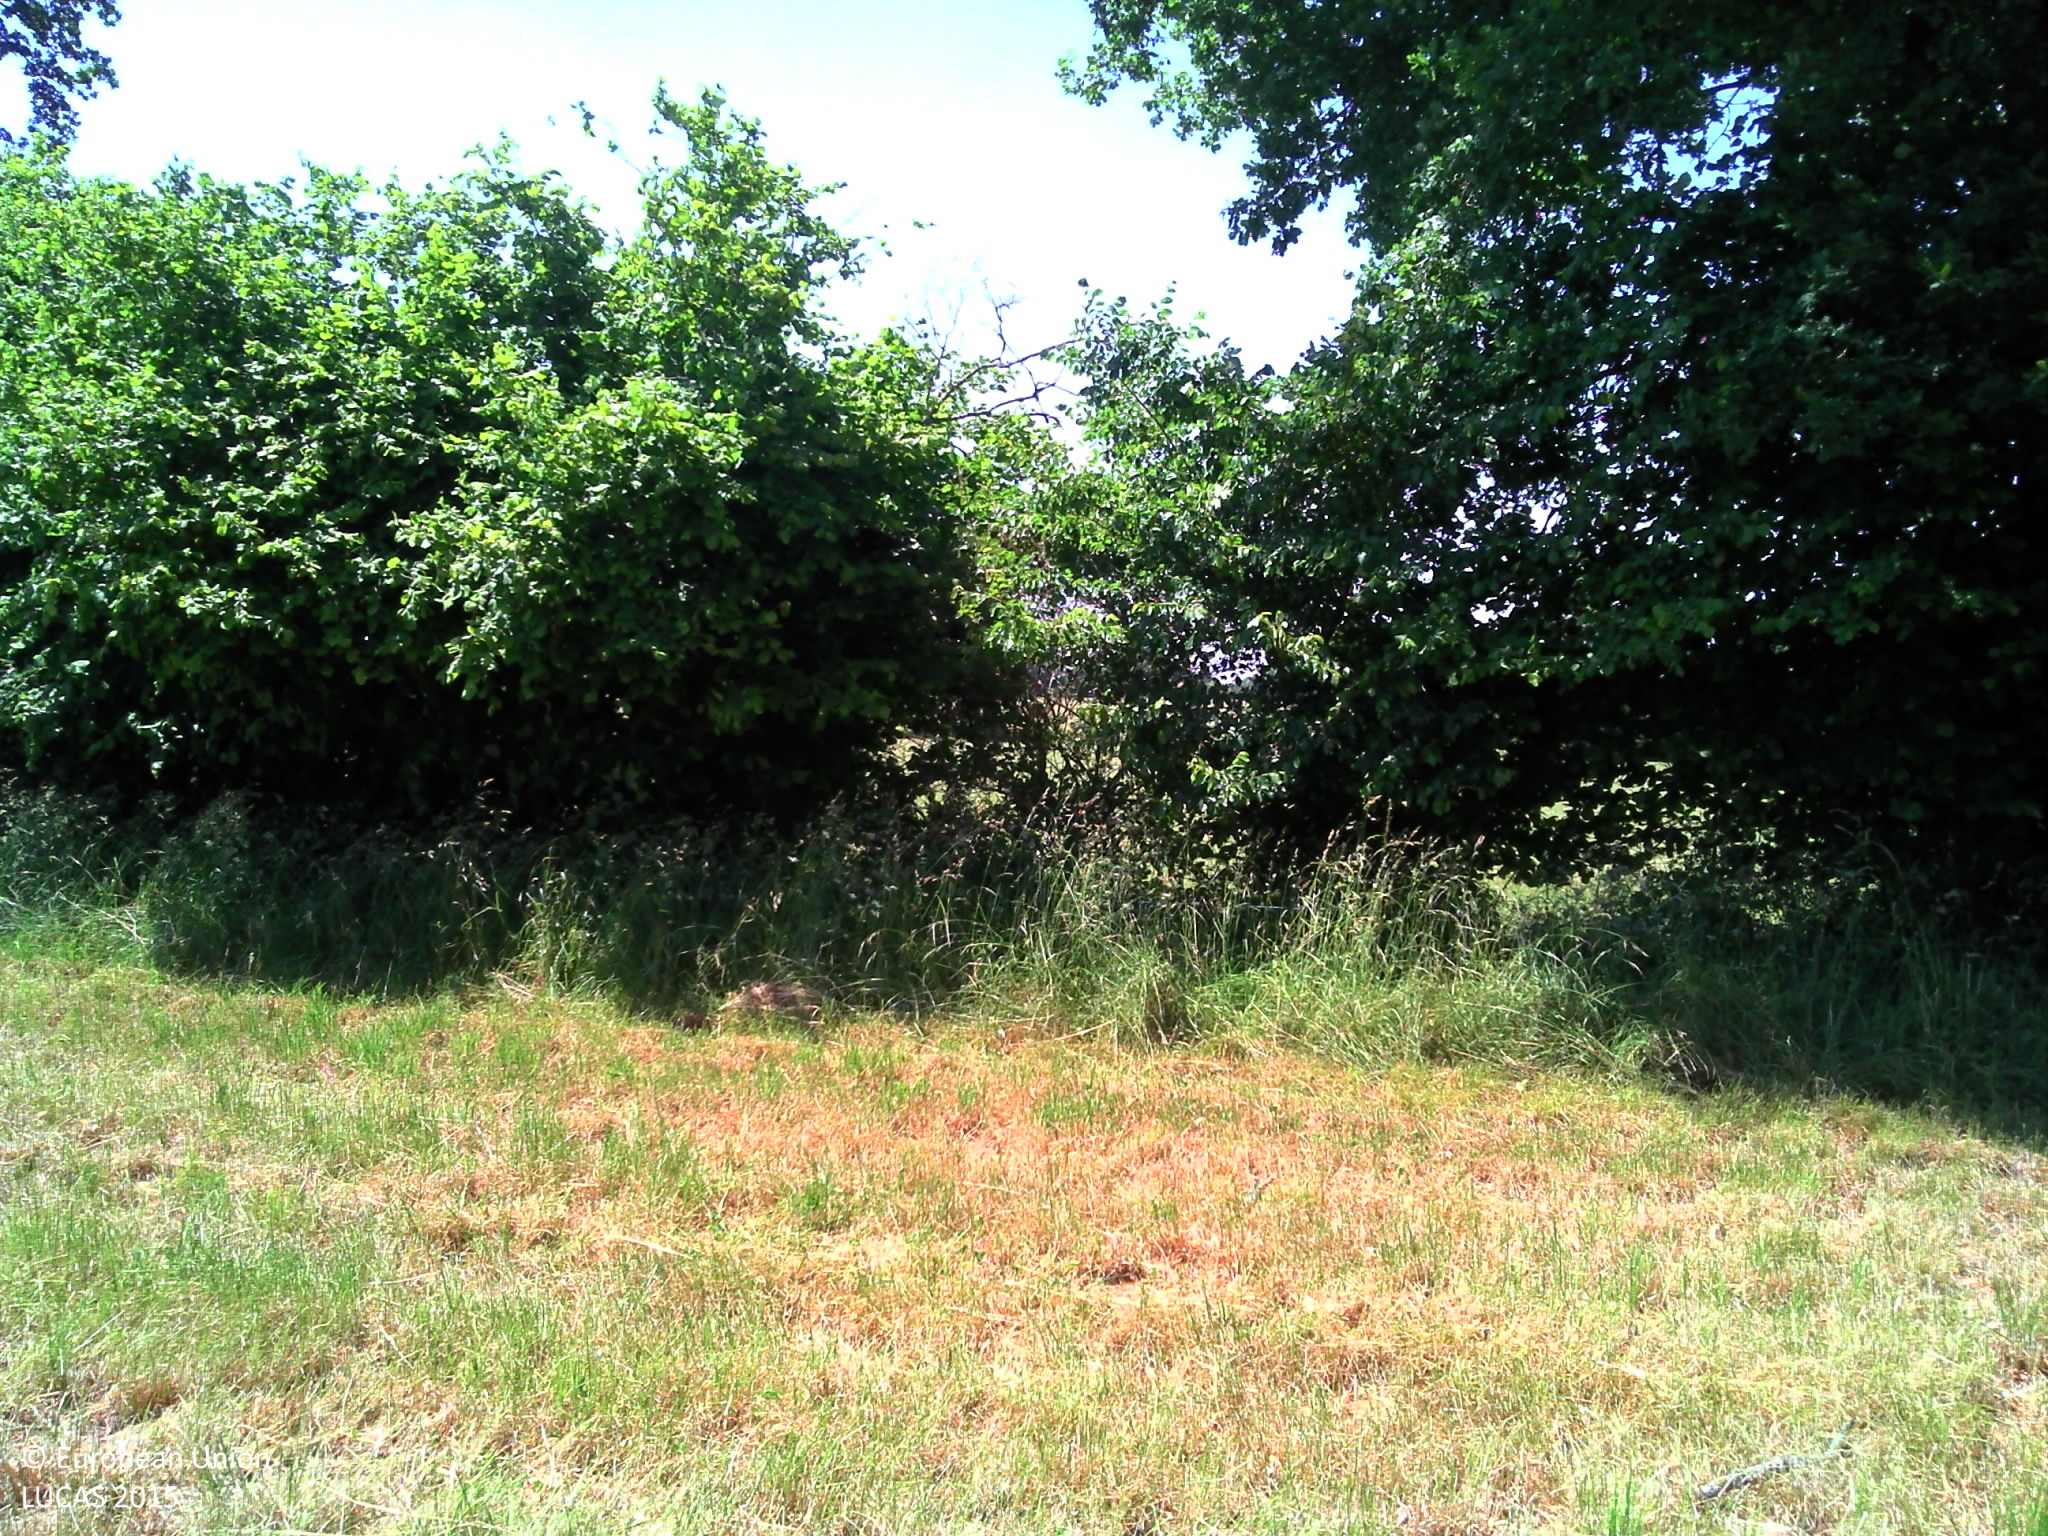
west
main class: Grassland
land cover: Grassland without tree/shrub cover
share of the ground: > 75 %
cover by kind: herbaceous plants 100 %
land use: Agriculture (excluding fallow land and kitchen gardens)
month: June
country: FR
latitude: 46.0778
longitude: 0.5585
